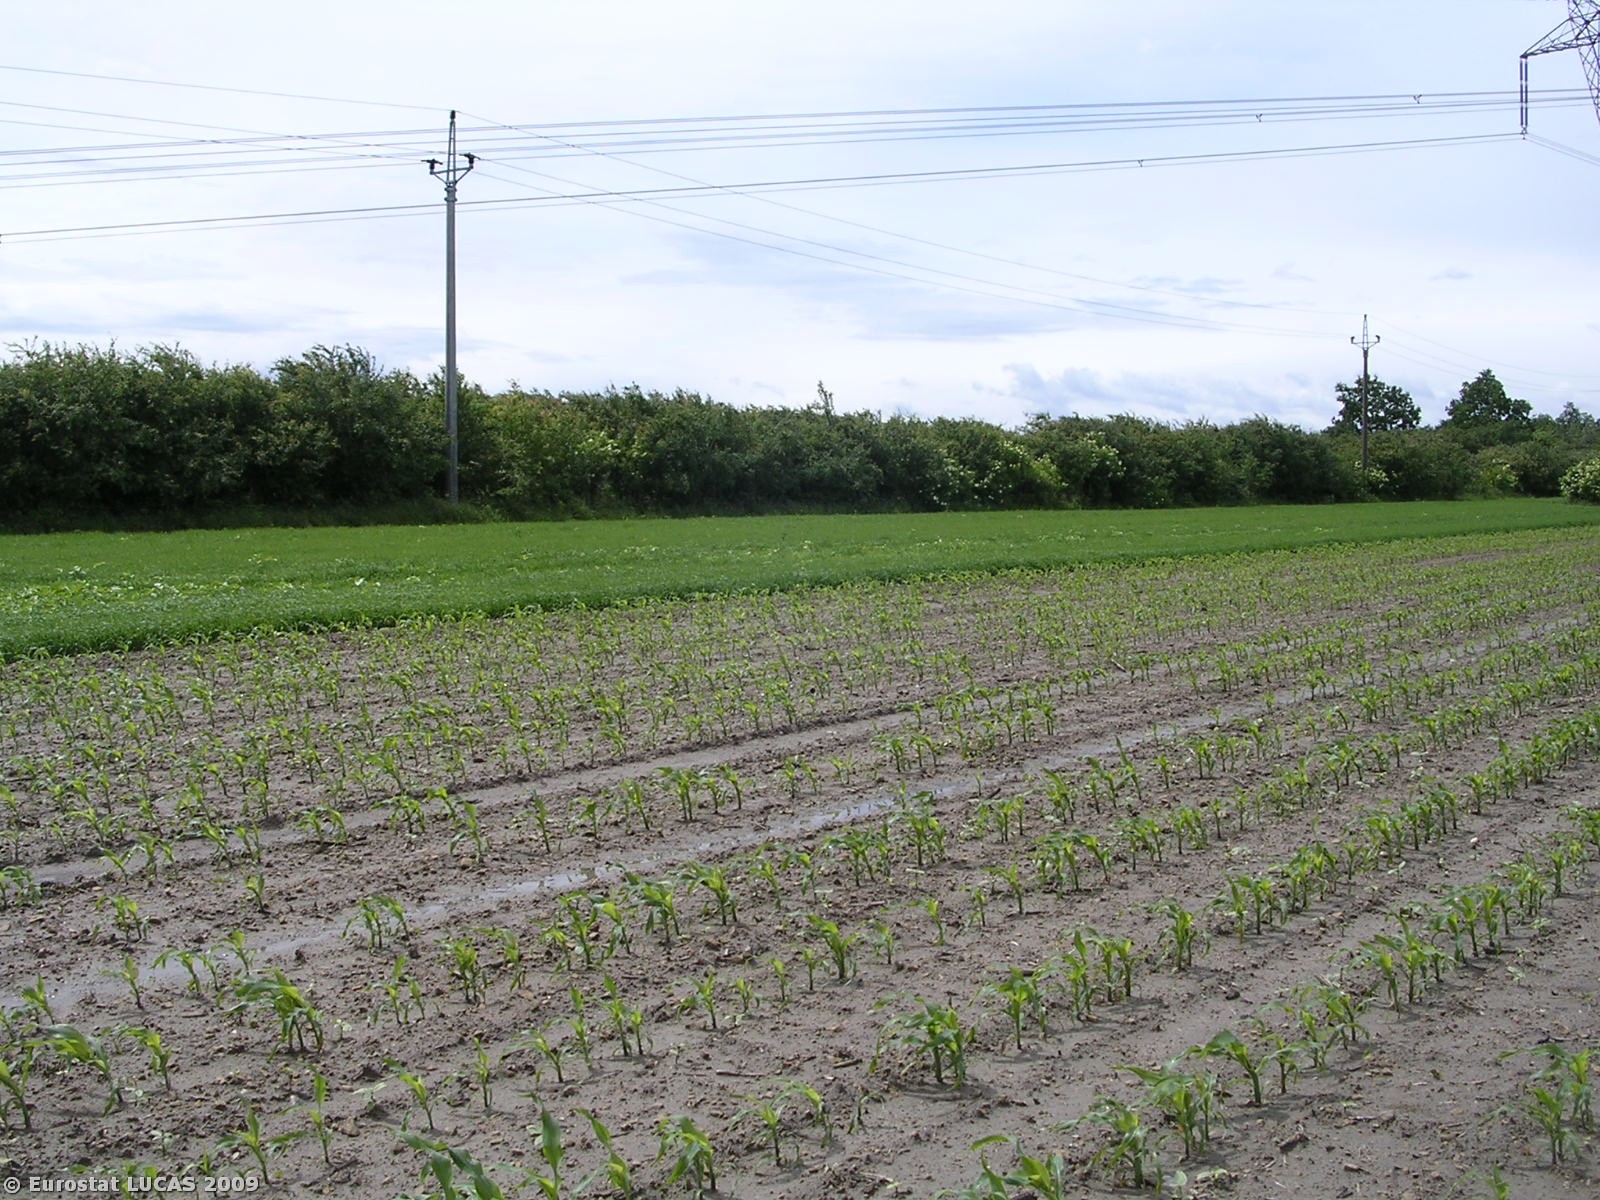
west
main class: Cropland
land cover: Maize
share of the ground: 10 - 25 %
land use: Agriculture (excluding fallow land and kitchen gardens)
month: May
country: CZ
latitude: 50.4222
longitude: 14.4353
